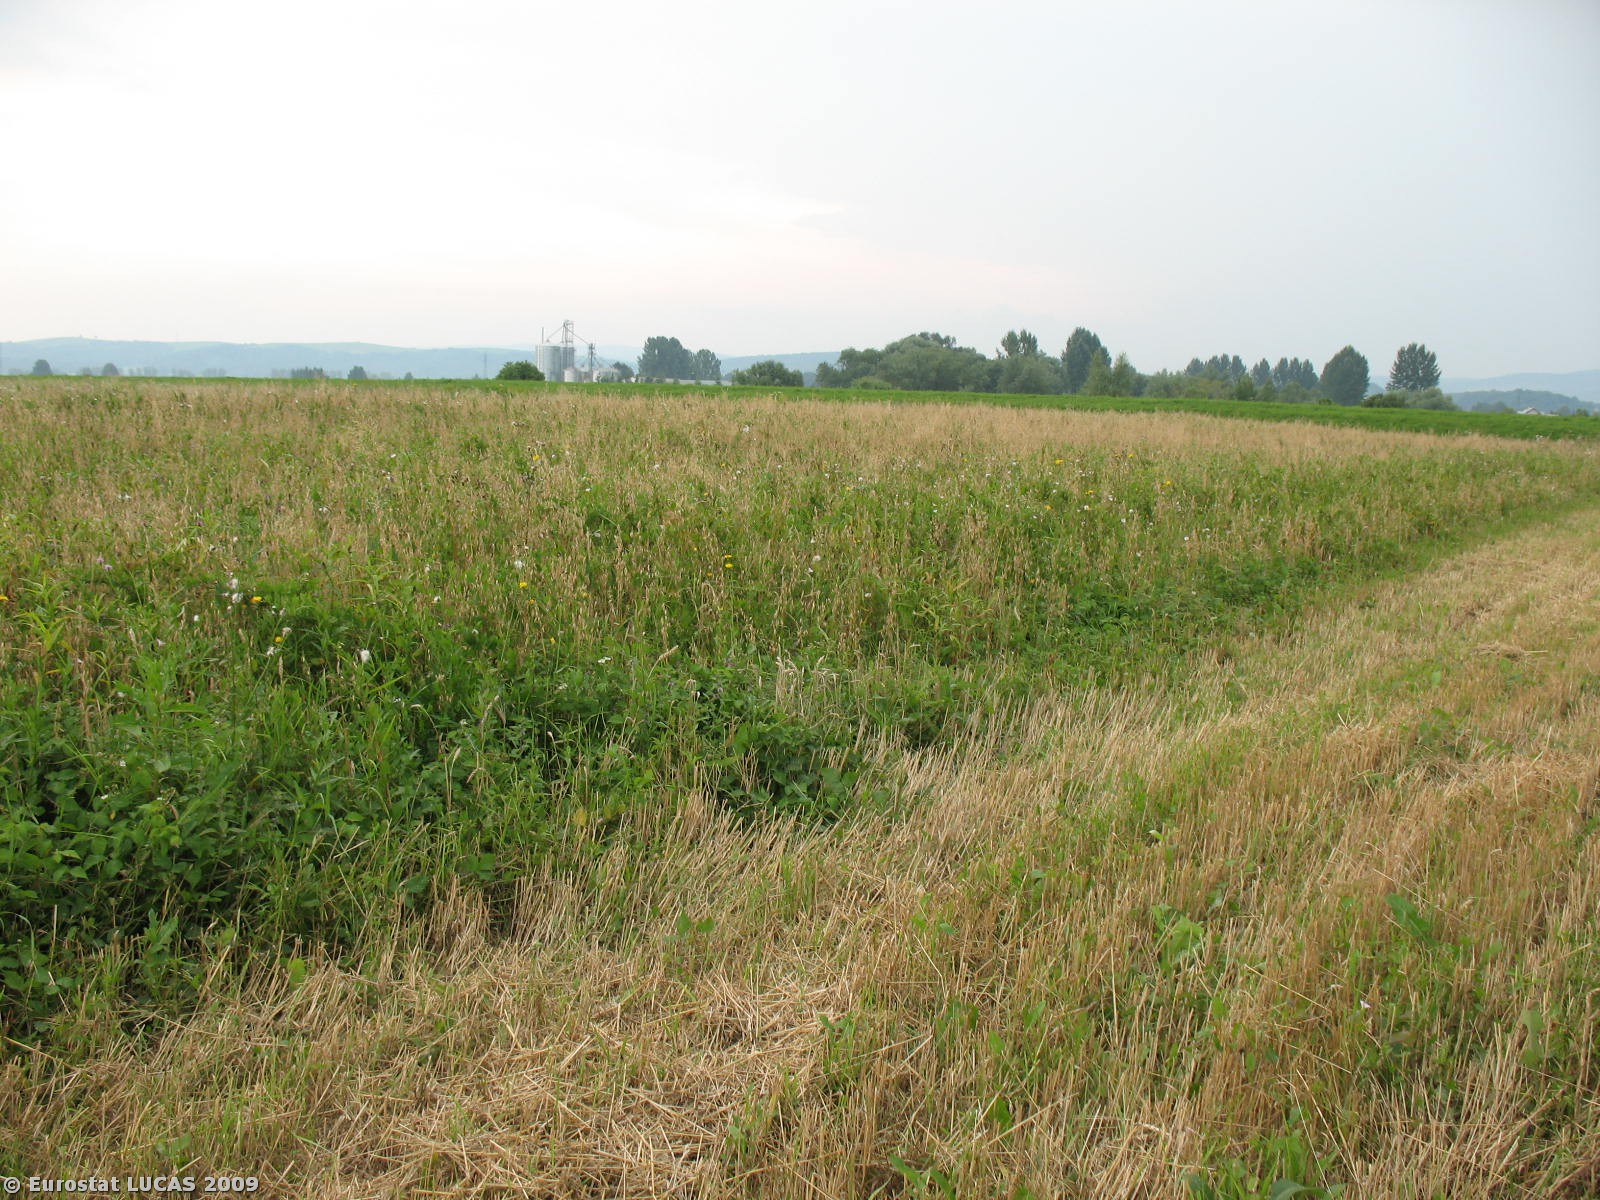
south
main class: Cropland
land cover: Common wheat
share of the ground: < 10 %
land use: Agriculture (excluding fallow land and kitchen gardens)
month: August
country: PL
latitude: 49.6054
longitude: 21.9707
